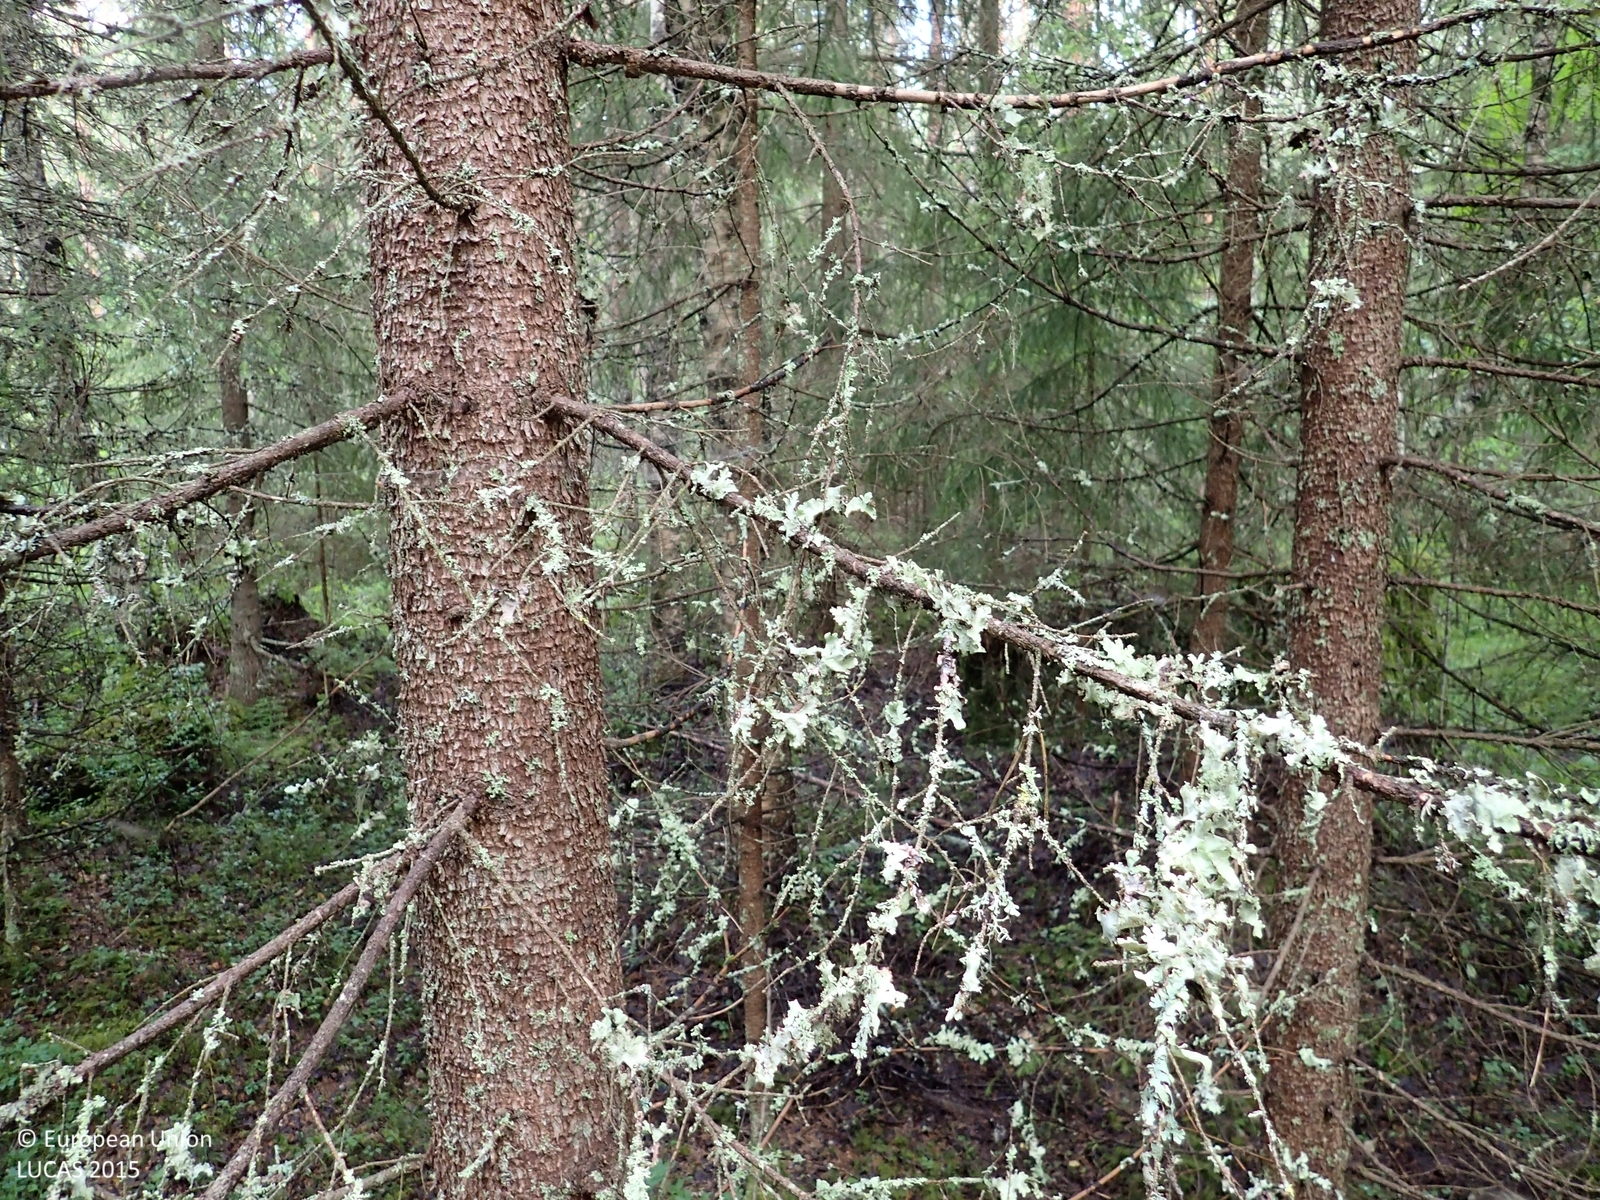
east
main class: Woodland
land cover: Spruce dominated coniferous woodland
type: boreal forest
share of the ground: > 75 %
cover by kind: coniferous forest trees 75 %, broadleaved forest trees 10 %, shrubs 10 %, lichens and mosses 5 %
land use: Forestry
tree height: > 5 m
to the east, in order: Spruce dominated coniferous woodland; Other coniferous woodland; Ditches and canals; Spruce dominated mixed woodland; Other mixed woodland; Pine dominated coniferous woodland
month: July
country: FI
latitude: 62.8791
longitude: 21.5434
